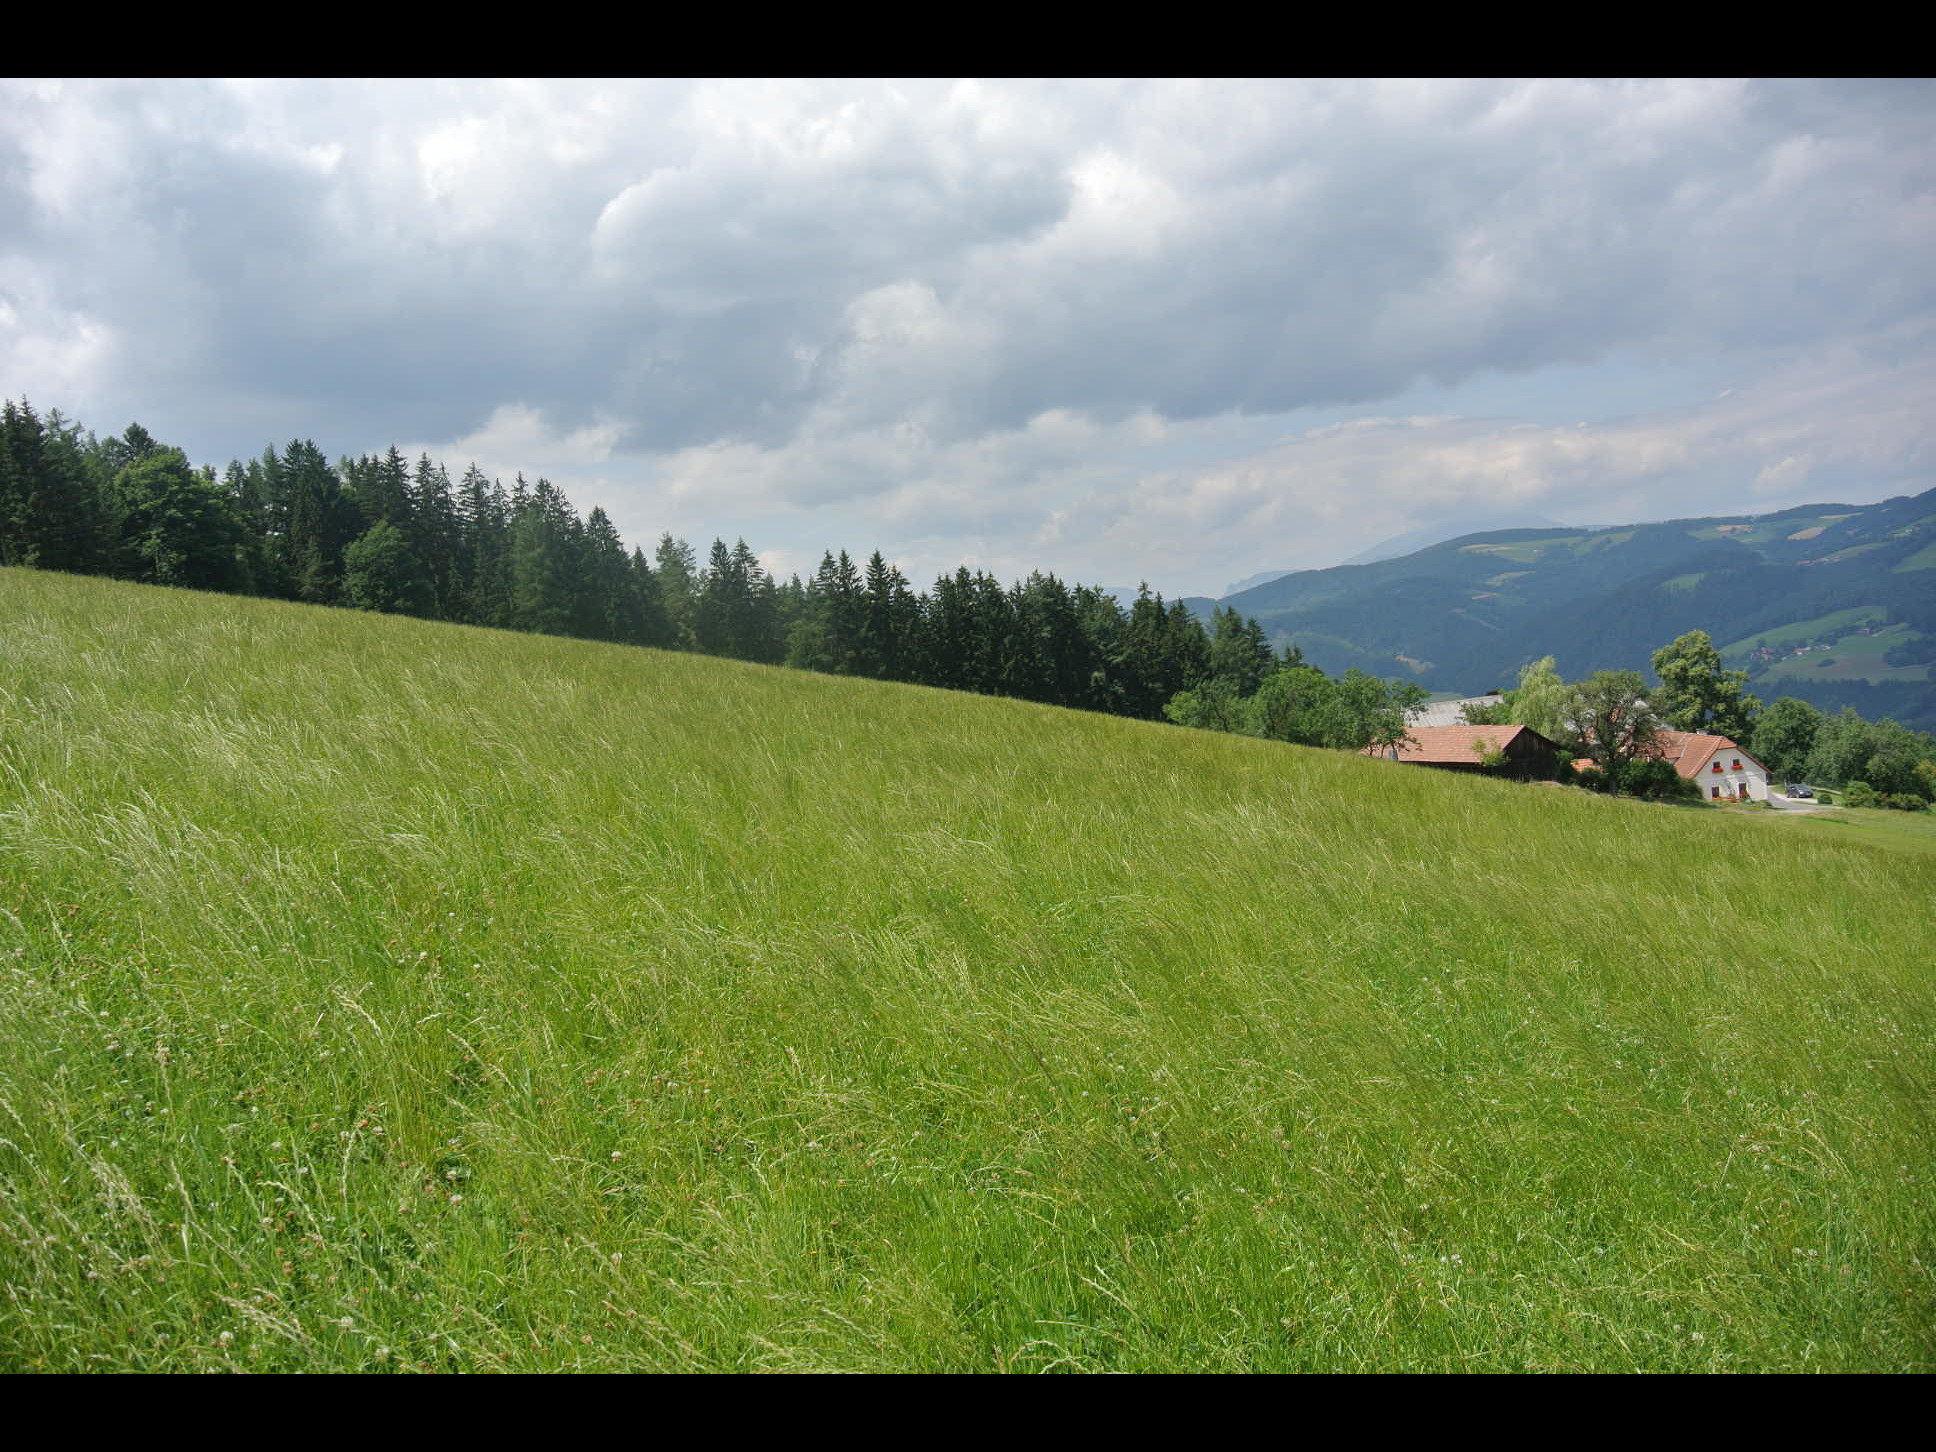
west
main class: Grassland
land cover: Grassland without tree/shrub cover
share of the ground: > 75 %
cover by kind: herbaceous plants 100 %
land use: Agriculture (excluding fallow land and kitchen gardens)
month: July
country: AT
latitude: 47.5880
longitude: 16.0529
